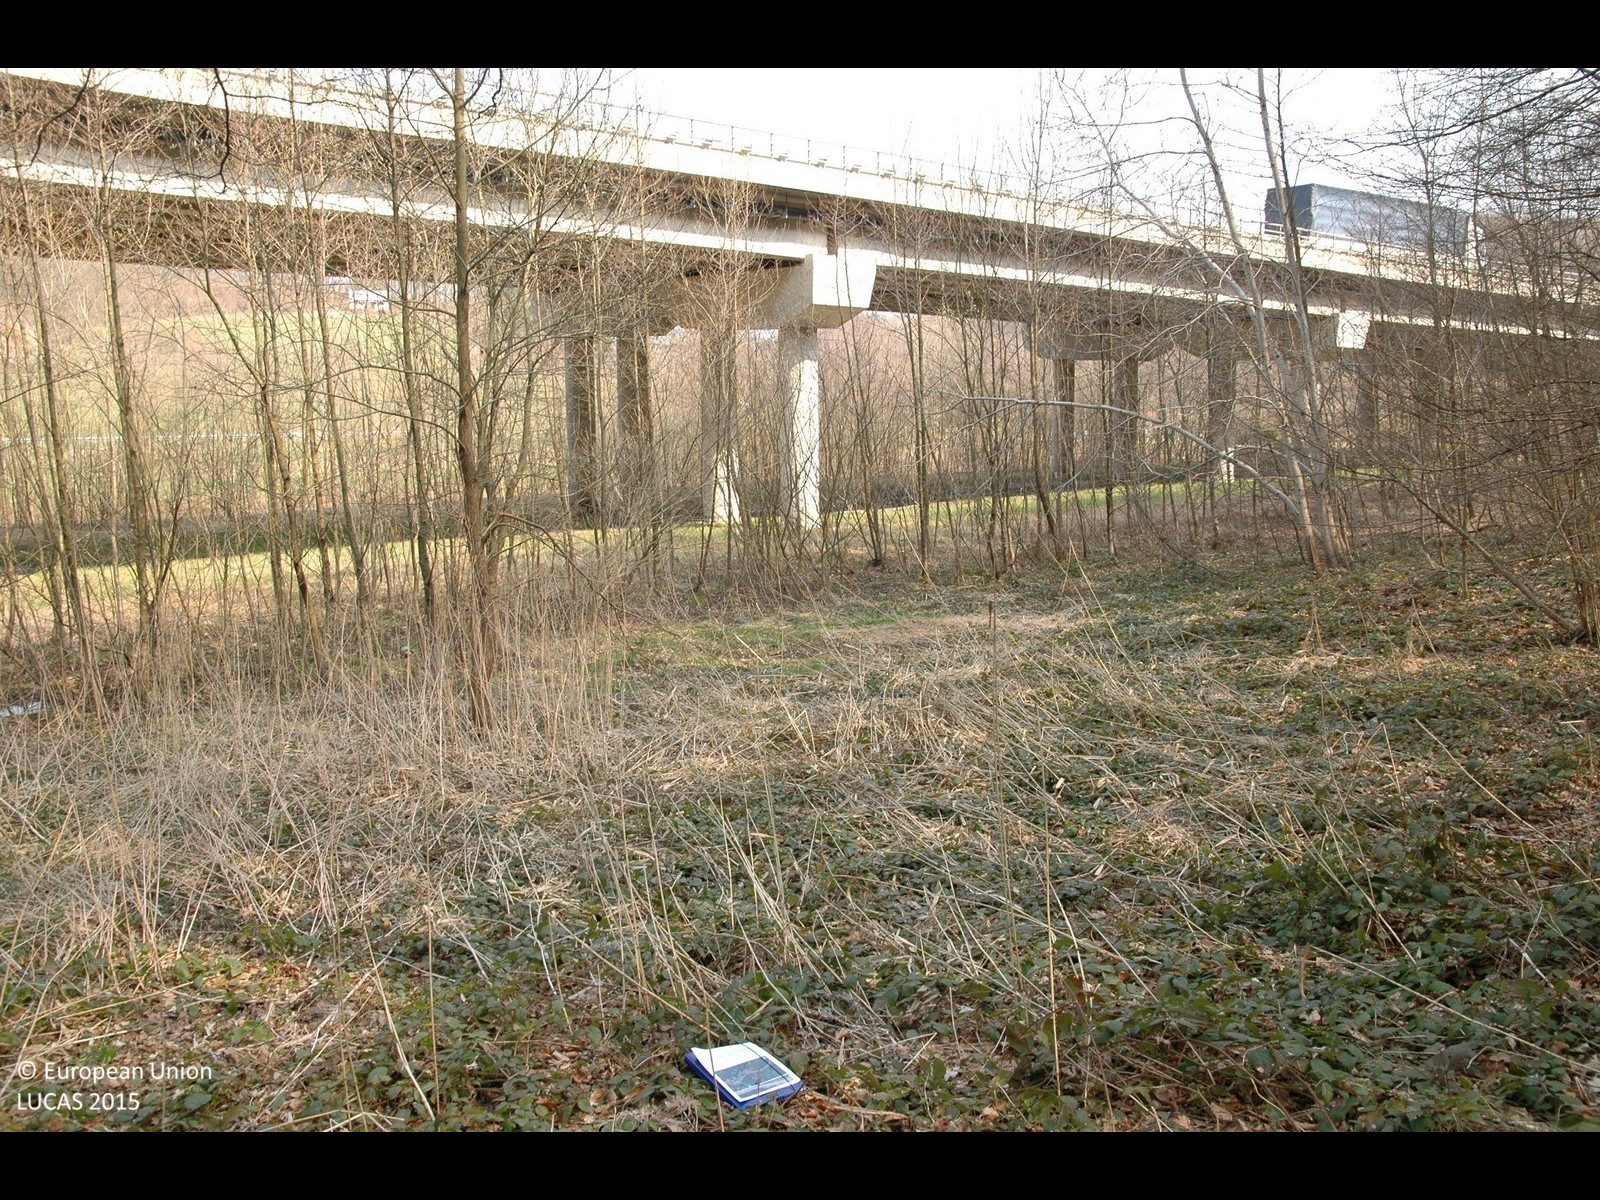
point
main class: Woodland
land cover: Broadleaved woodland
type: mesophytic deciduous forest
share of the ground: > 75 %
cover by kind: broadleaved forest trees 90 %
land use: Forestry
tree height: > 5 m
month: March
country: HR
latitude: 46.1277
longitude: 16.3284
